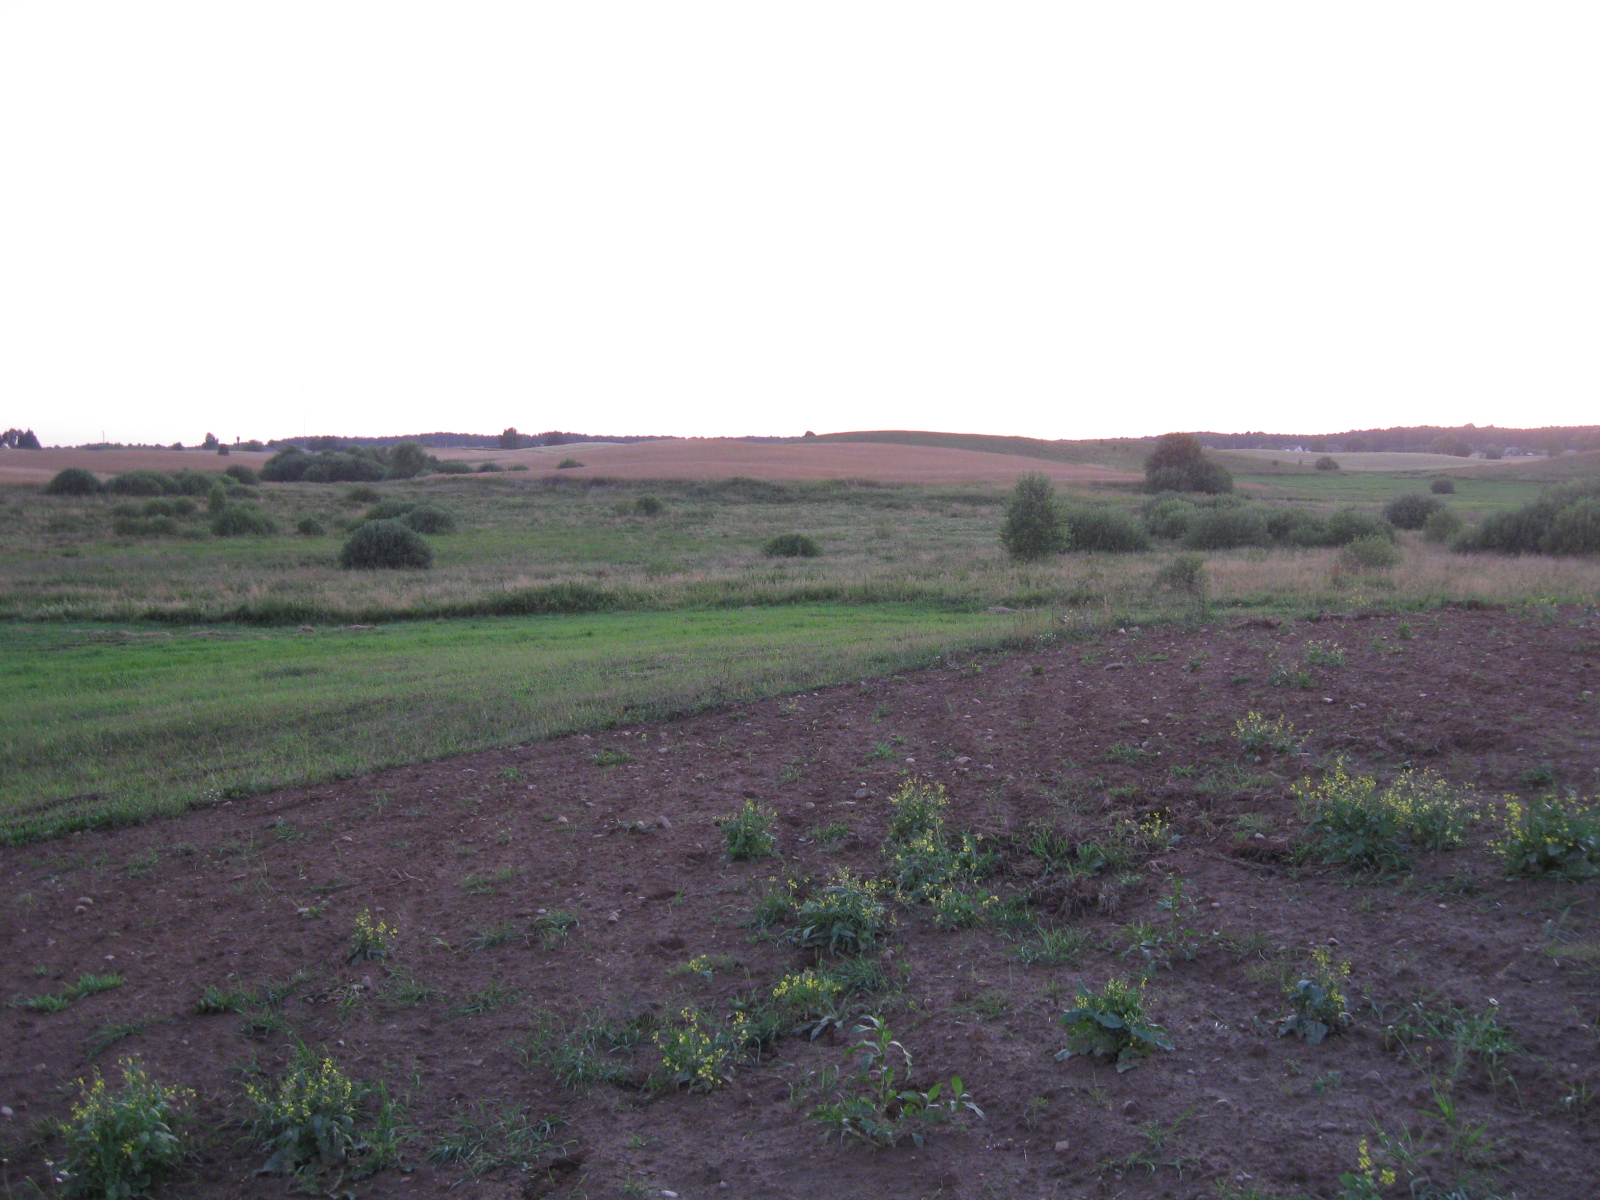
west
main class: Grassland
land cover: Spontaneously vegetated surfaces
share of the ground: 10 - 25 %
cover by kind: unconsolidated bare surface 80 %, herbaceous plants 20 %
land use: Agriculture (excluding fallow land and kitchen gardens)
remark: Tilled/Sowed
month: July
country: LT
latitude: 54.1098
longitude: 23.7469
